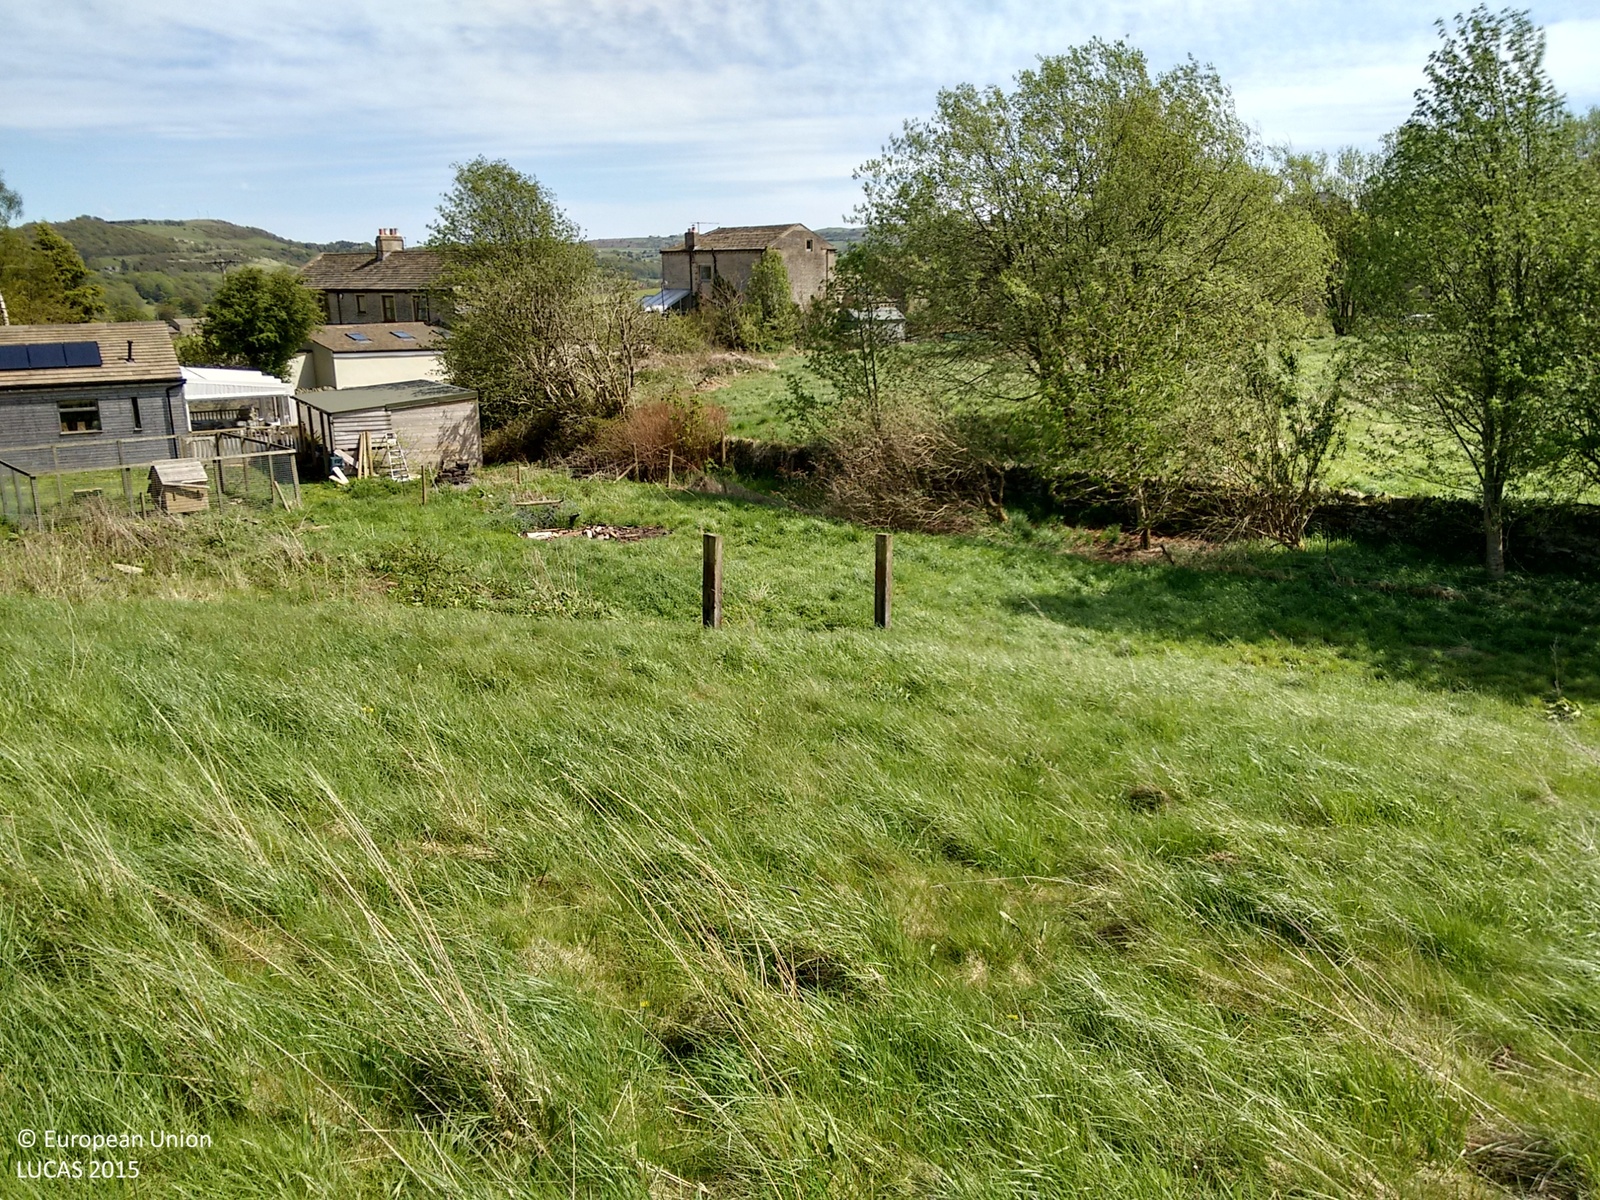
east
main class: Grassland
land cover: Grassland without tree/shrub cover
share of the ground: > 75 %
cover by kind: herbaceous plants 100 %
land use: Agriculture (excluding fallow land and kitchen gardens)
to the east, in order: Grassland without tree/shrub cover; Fences; Artificial constructions in urban areas; Broadleaved woodland; Grassland without tree/shrub cover; Broadleaved woodland; Dry stone walls; Grassland without tree/shrub cover
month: May
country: GB
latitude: 53.5869
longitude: -1.7919
